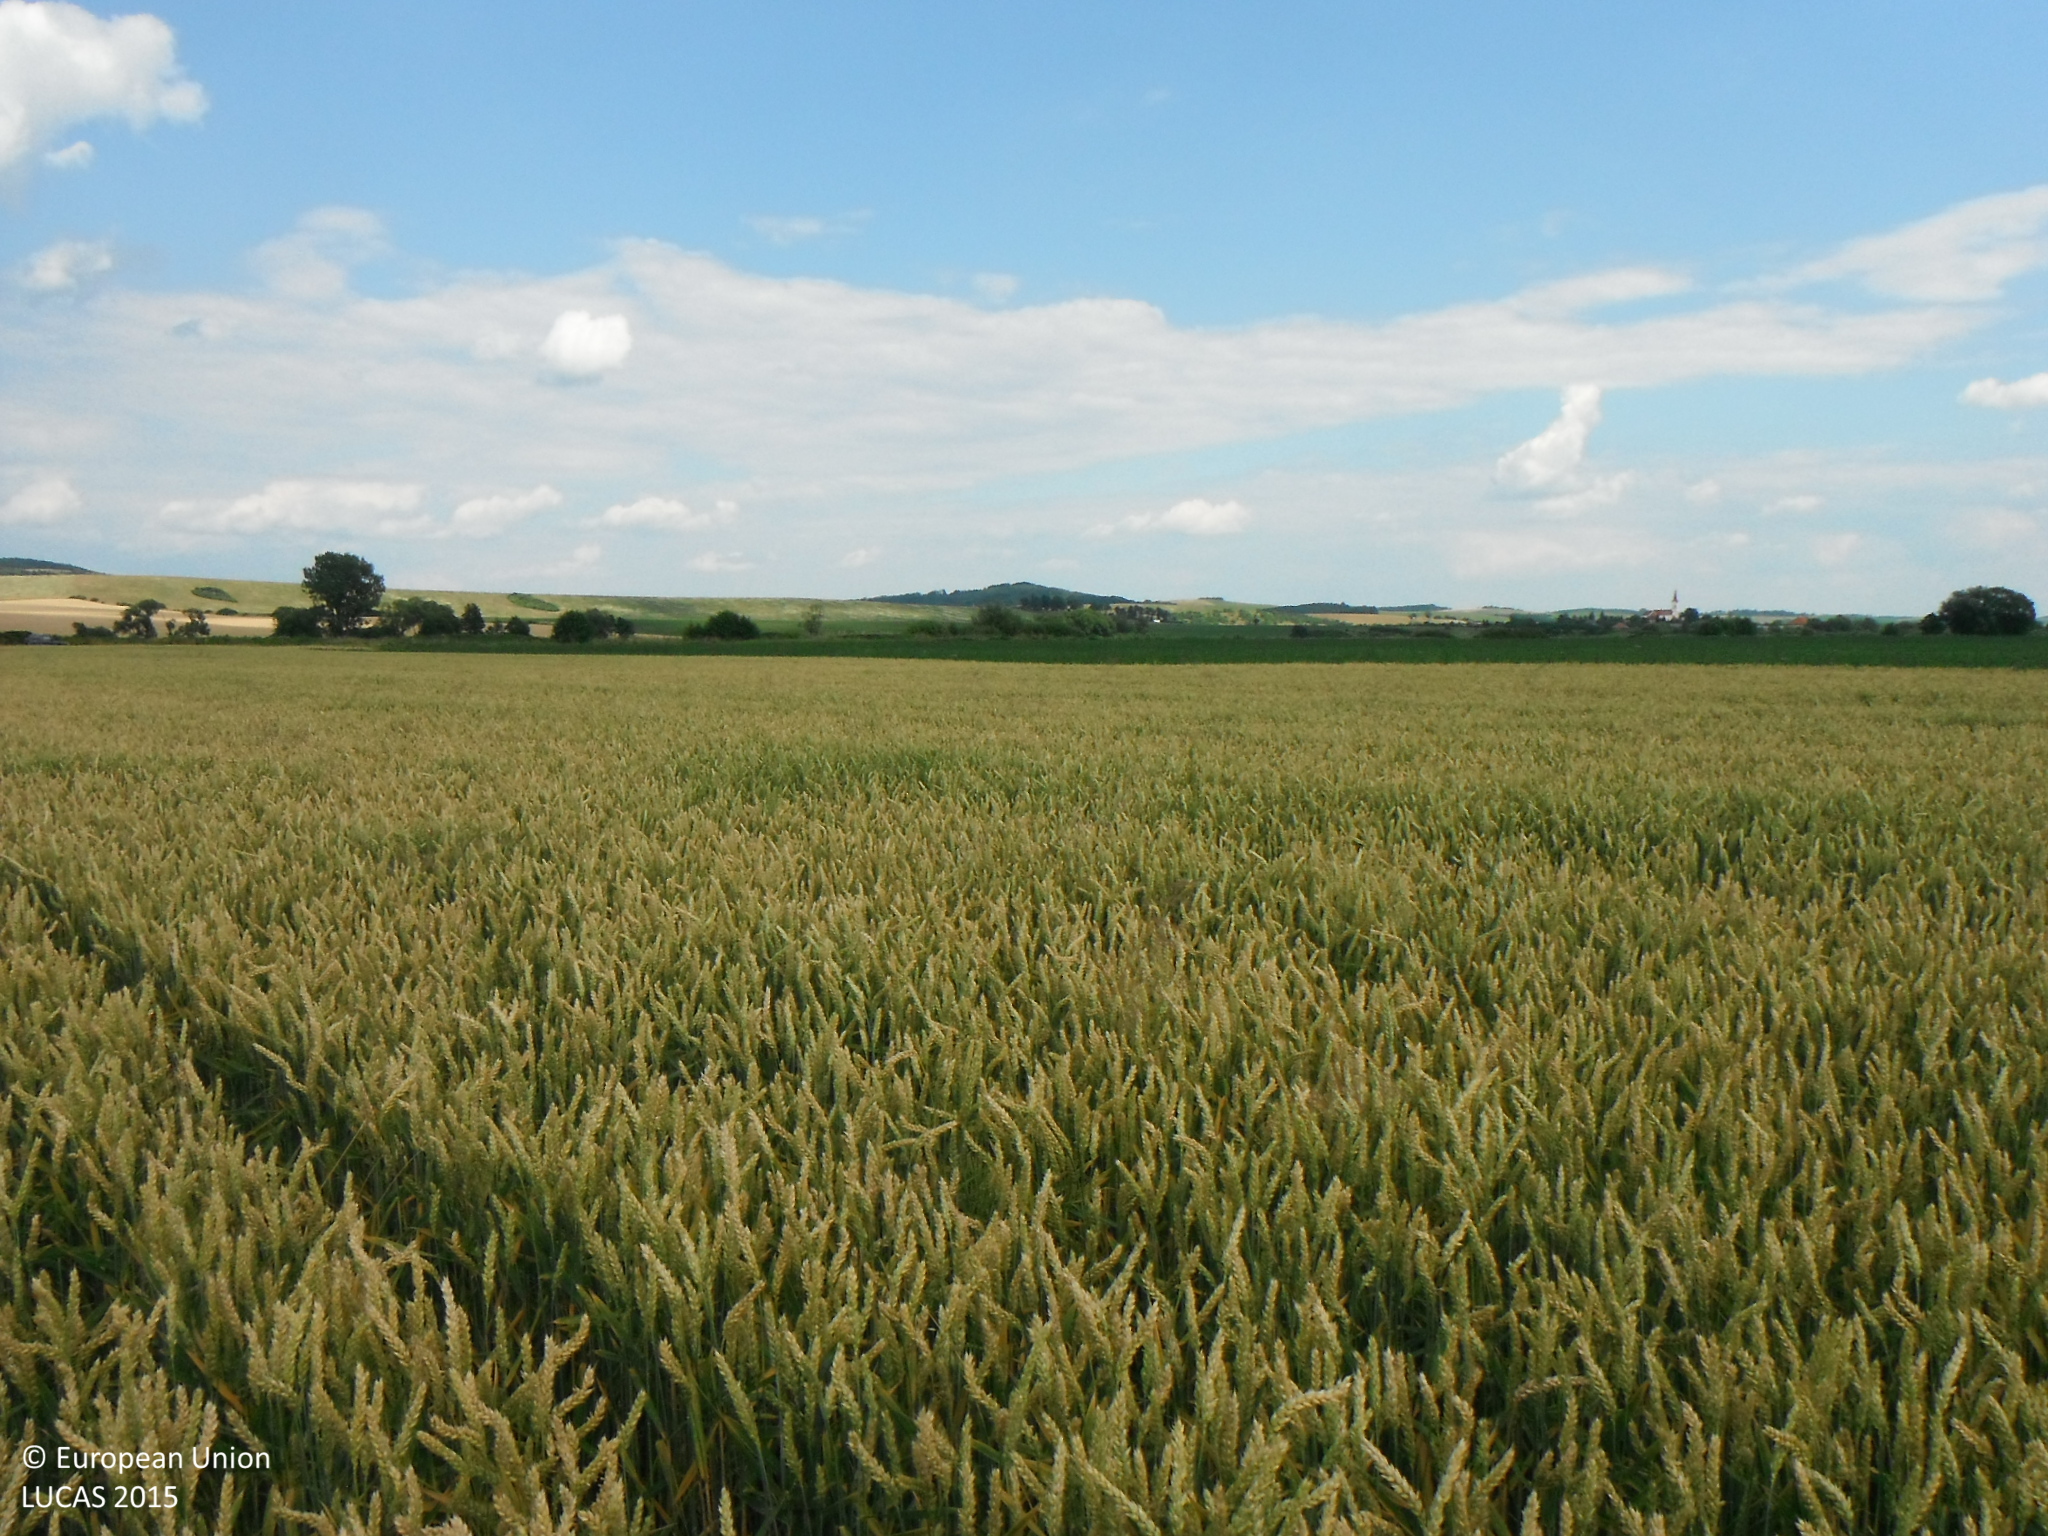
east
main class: Cropland
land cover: Common wheat
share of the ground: > 75 %
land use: Agriculture (excluding fallow land and kitchen gardens)
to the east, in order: Common wheat; Soya; Tracks; Spontaneously vegetated surfaces; Shrubland with sparse tree cover; Ditches and canals; Spontaneously vegetated surfaces; Soya
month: June
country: SK
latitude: 48.4270
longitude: 20.1258
